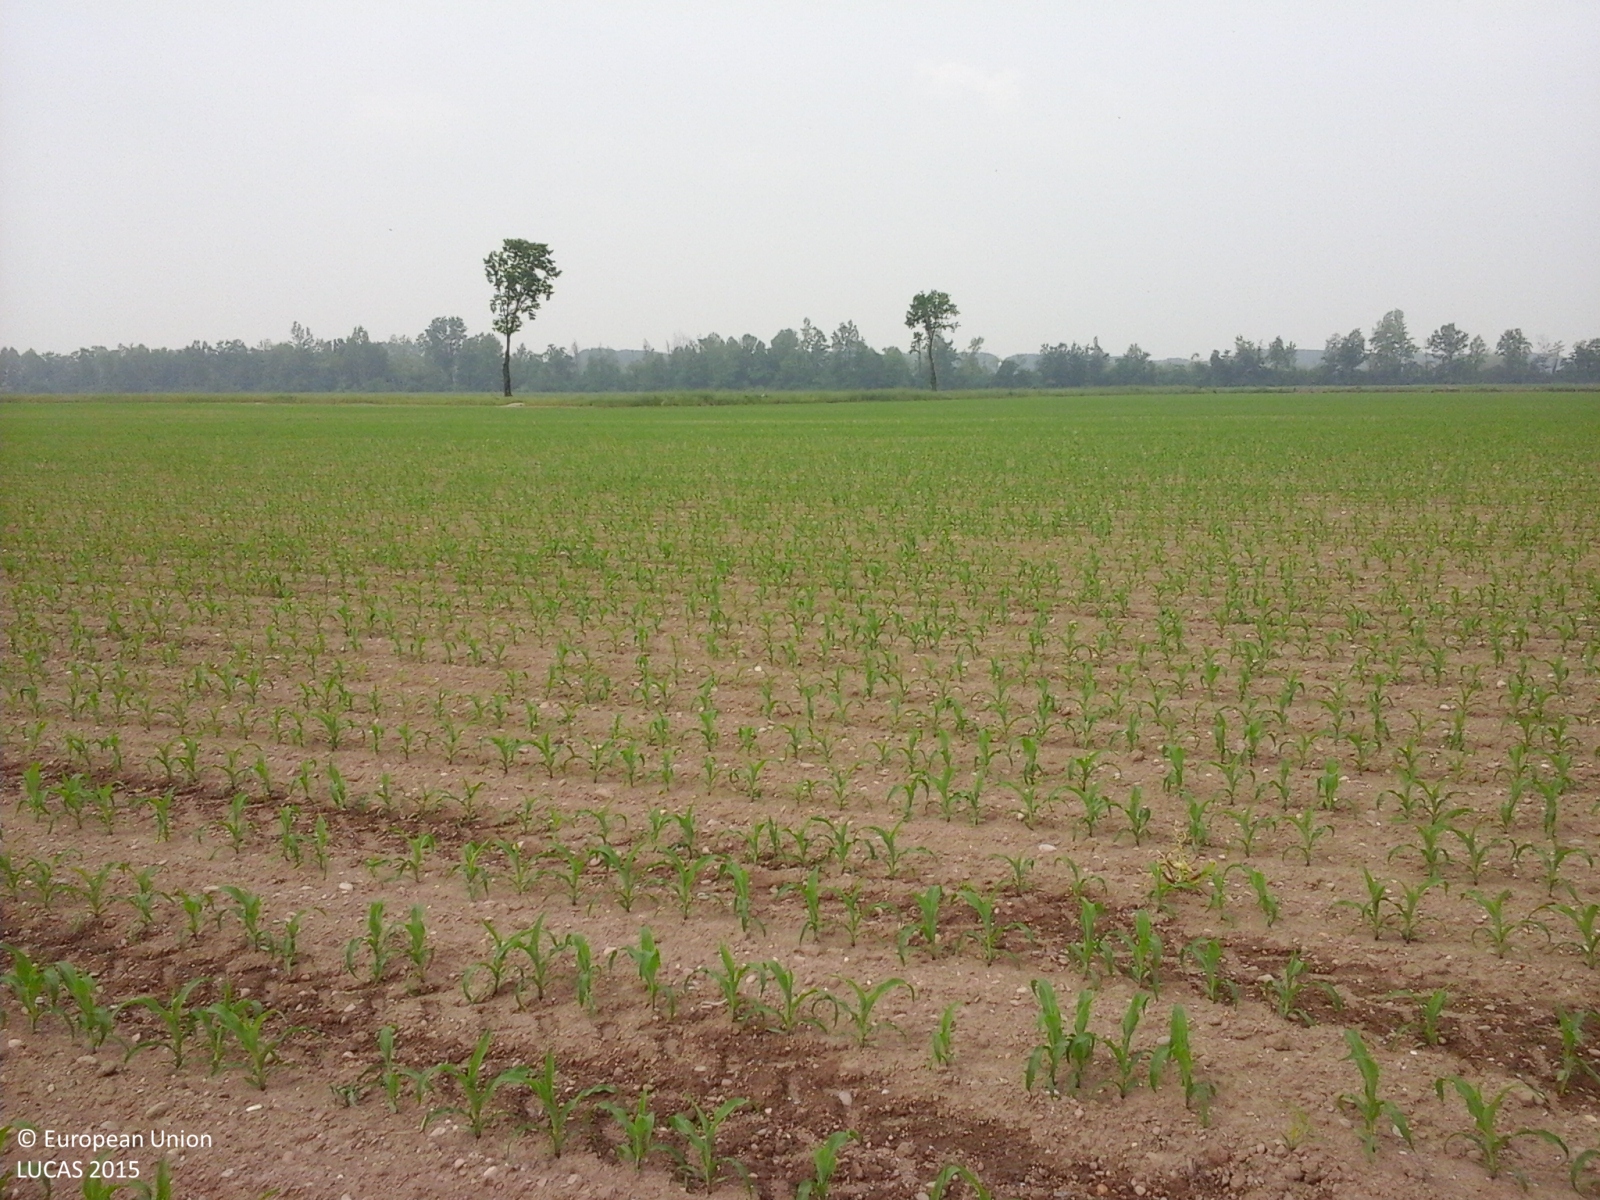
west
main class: Cropland
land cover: Maize
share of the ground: 10 - 25 %
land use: Agriculture (excluding fallow land and kitchen gardens)
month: May
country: IT
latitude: 45.3421
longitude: 9.8599
